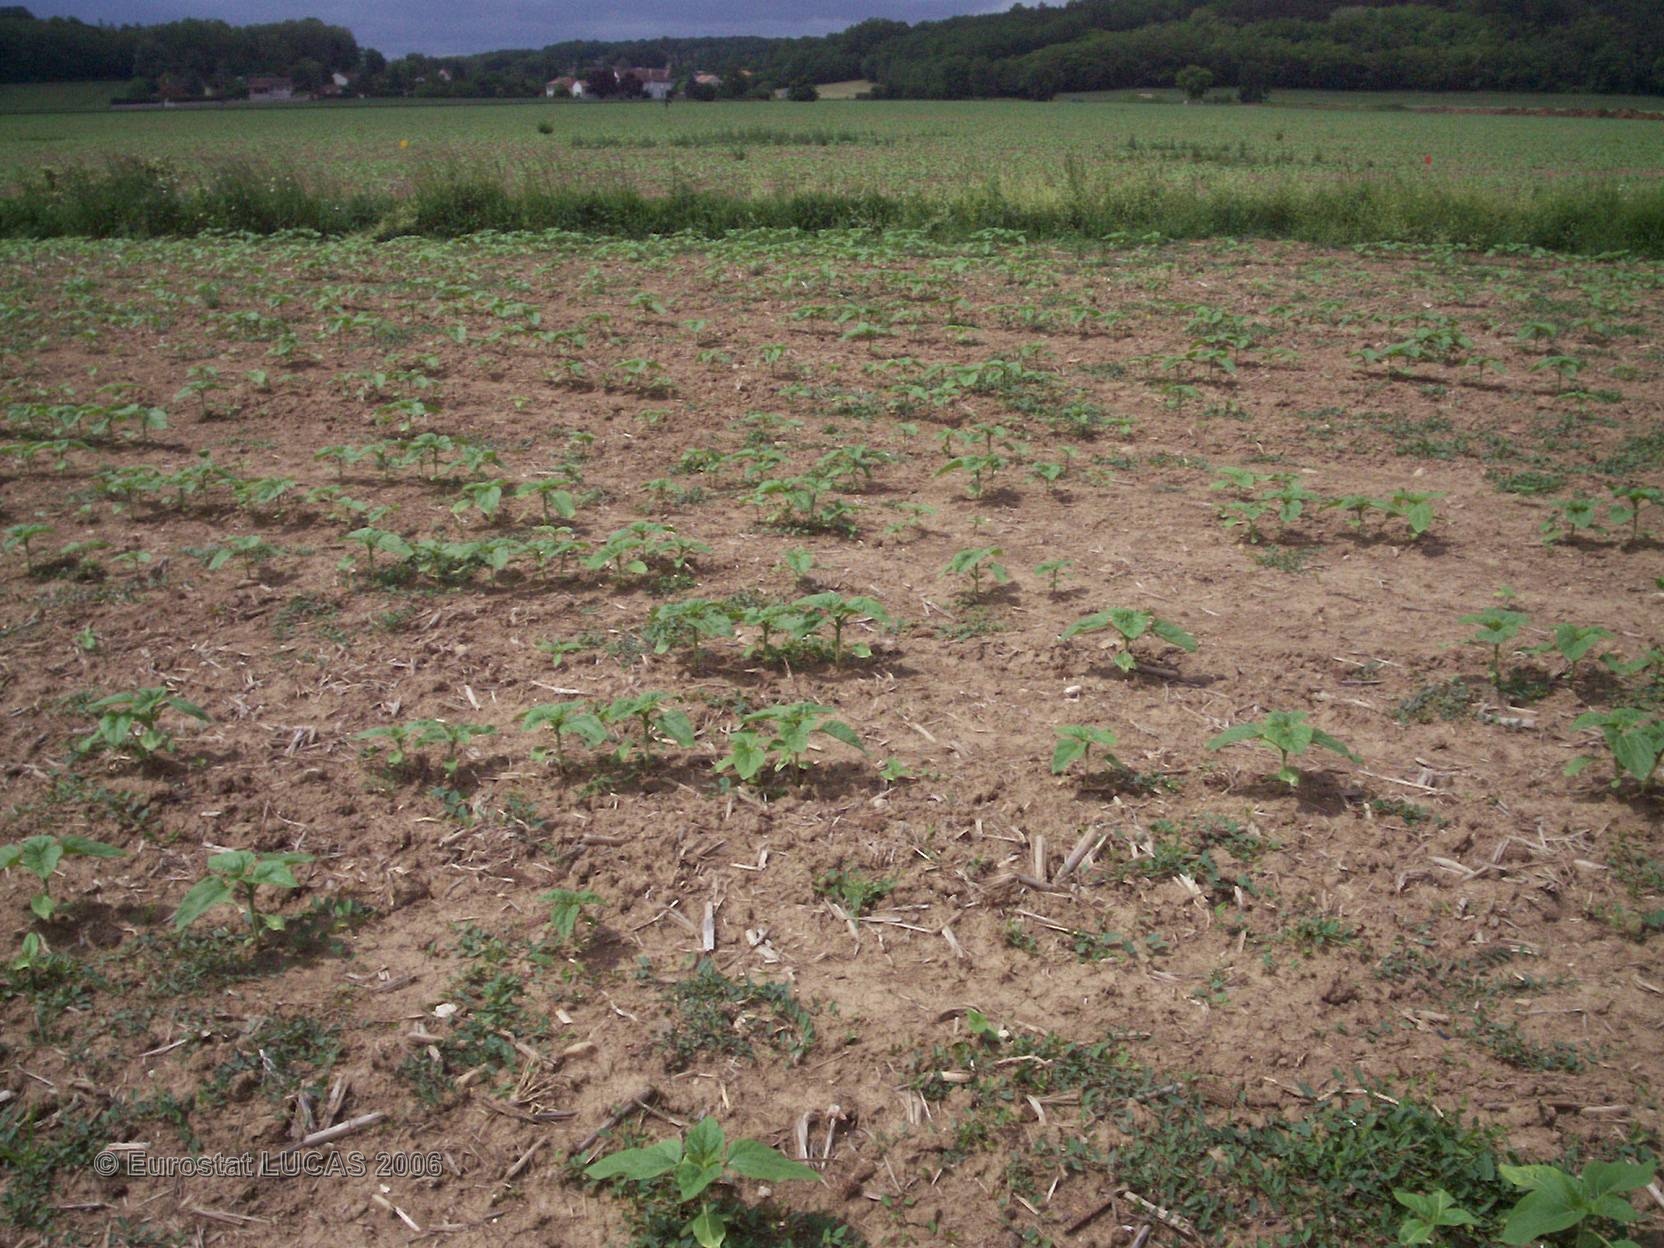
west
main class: Cropland
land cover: Sunflower
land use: Agriculture (excluding fallow land and kitchen gardens)
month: May
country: FR
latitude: 46.6937
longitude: 0.5539
